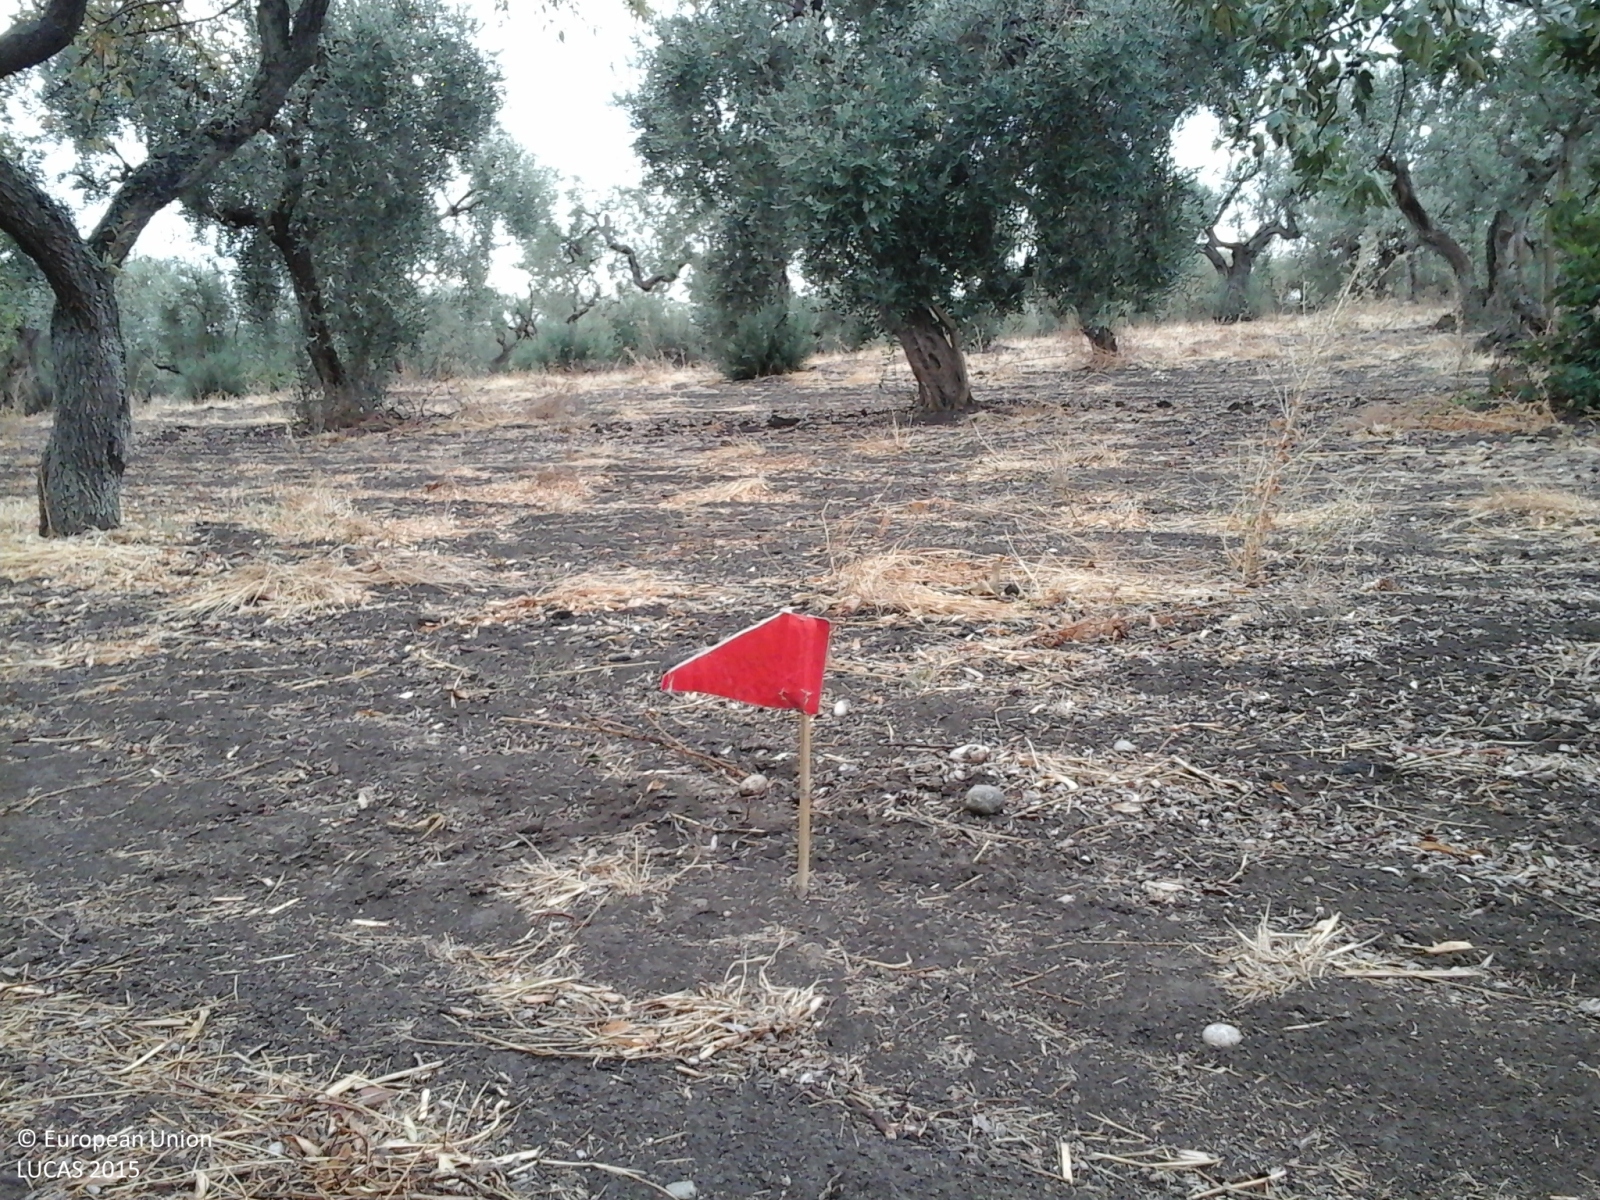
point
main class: Cropland
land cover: Olive groves
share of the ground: > 75 %
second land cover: Other bare soil
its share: > 75 %
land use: Agriculture (excluding fallow land and kitchen gardens)
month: September
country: IT
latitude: 41.7980
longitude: 15.1708
